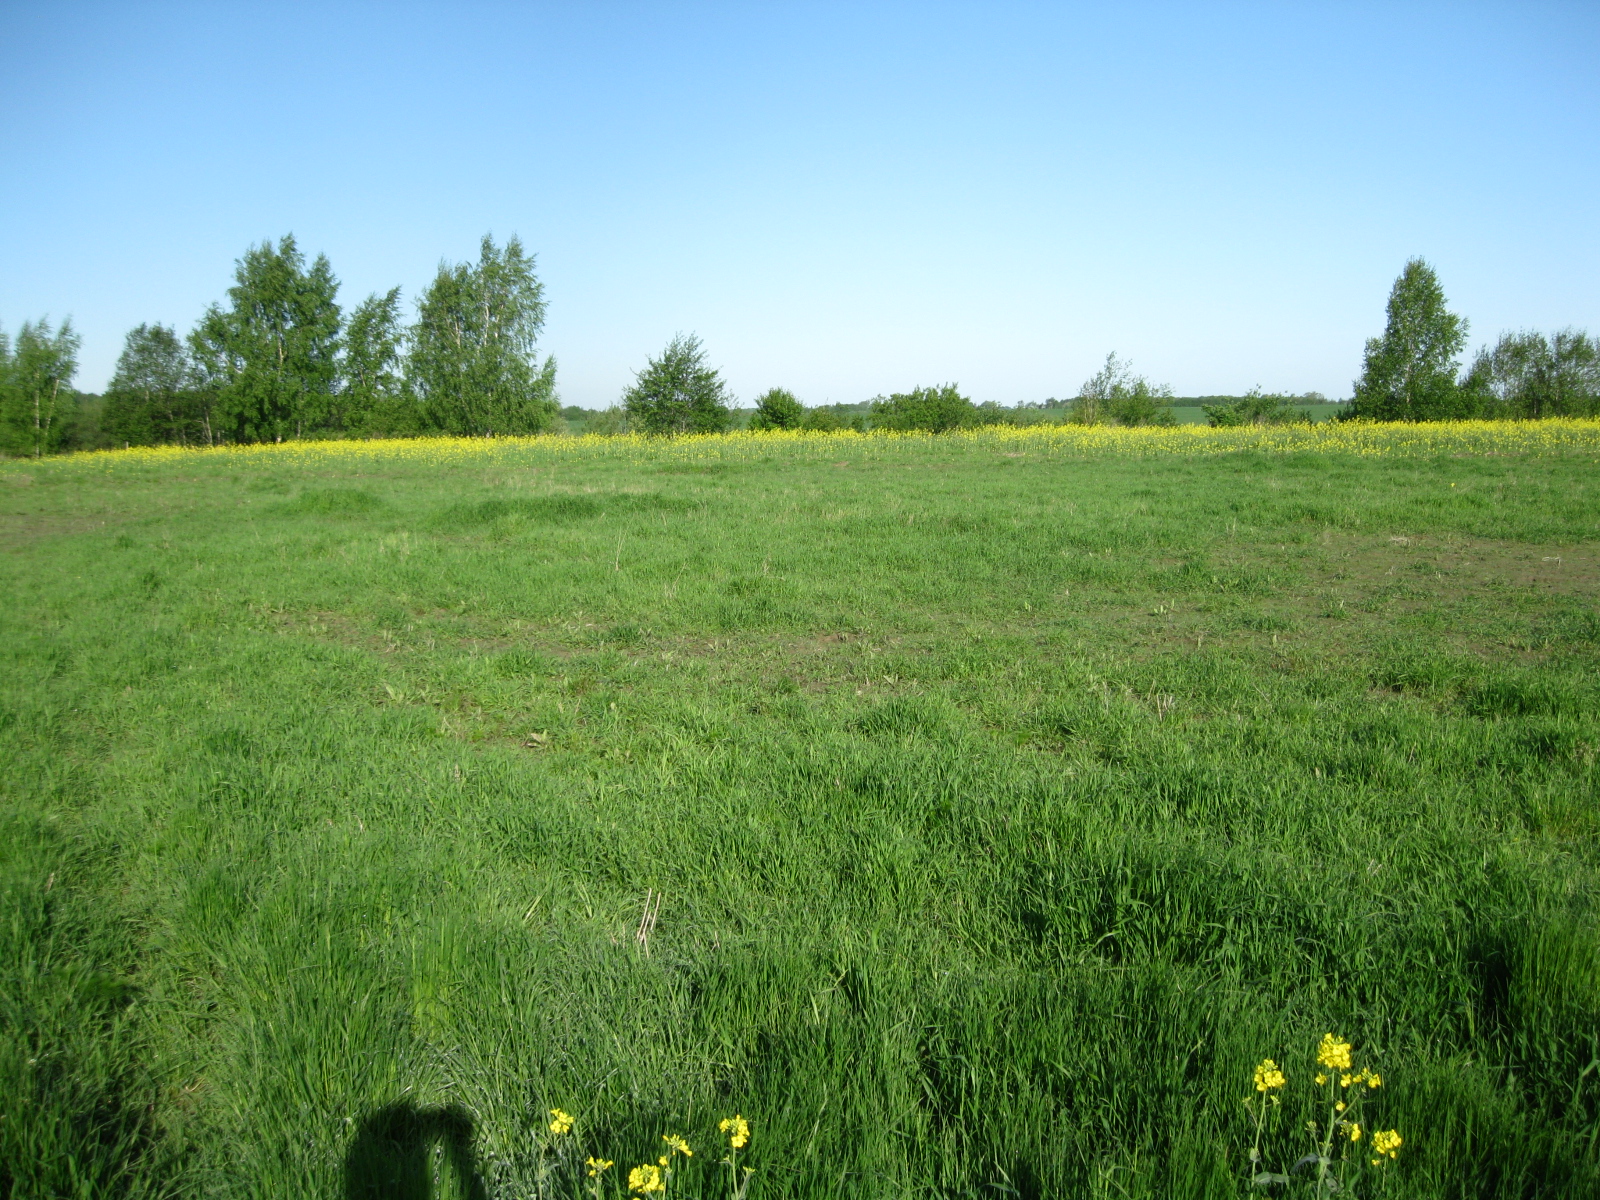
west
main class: Cropland
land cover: Rape and turnip rape
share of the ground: > 75 %
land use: Agriculture (excluding fallow land and kitchen gardens)
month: May
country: LT
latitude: 56.1839
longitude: 23.9905
